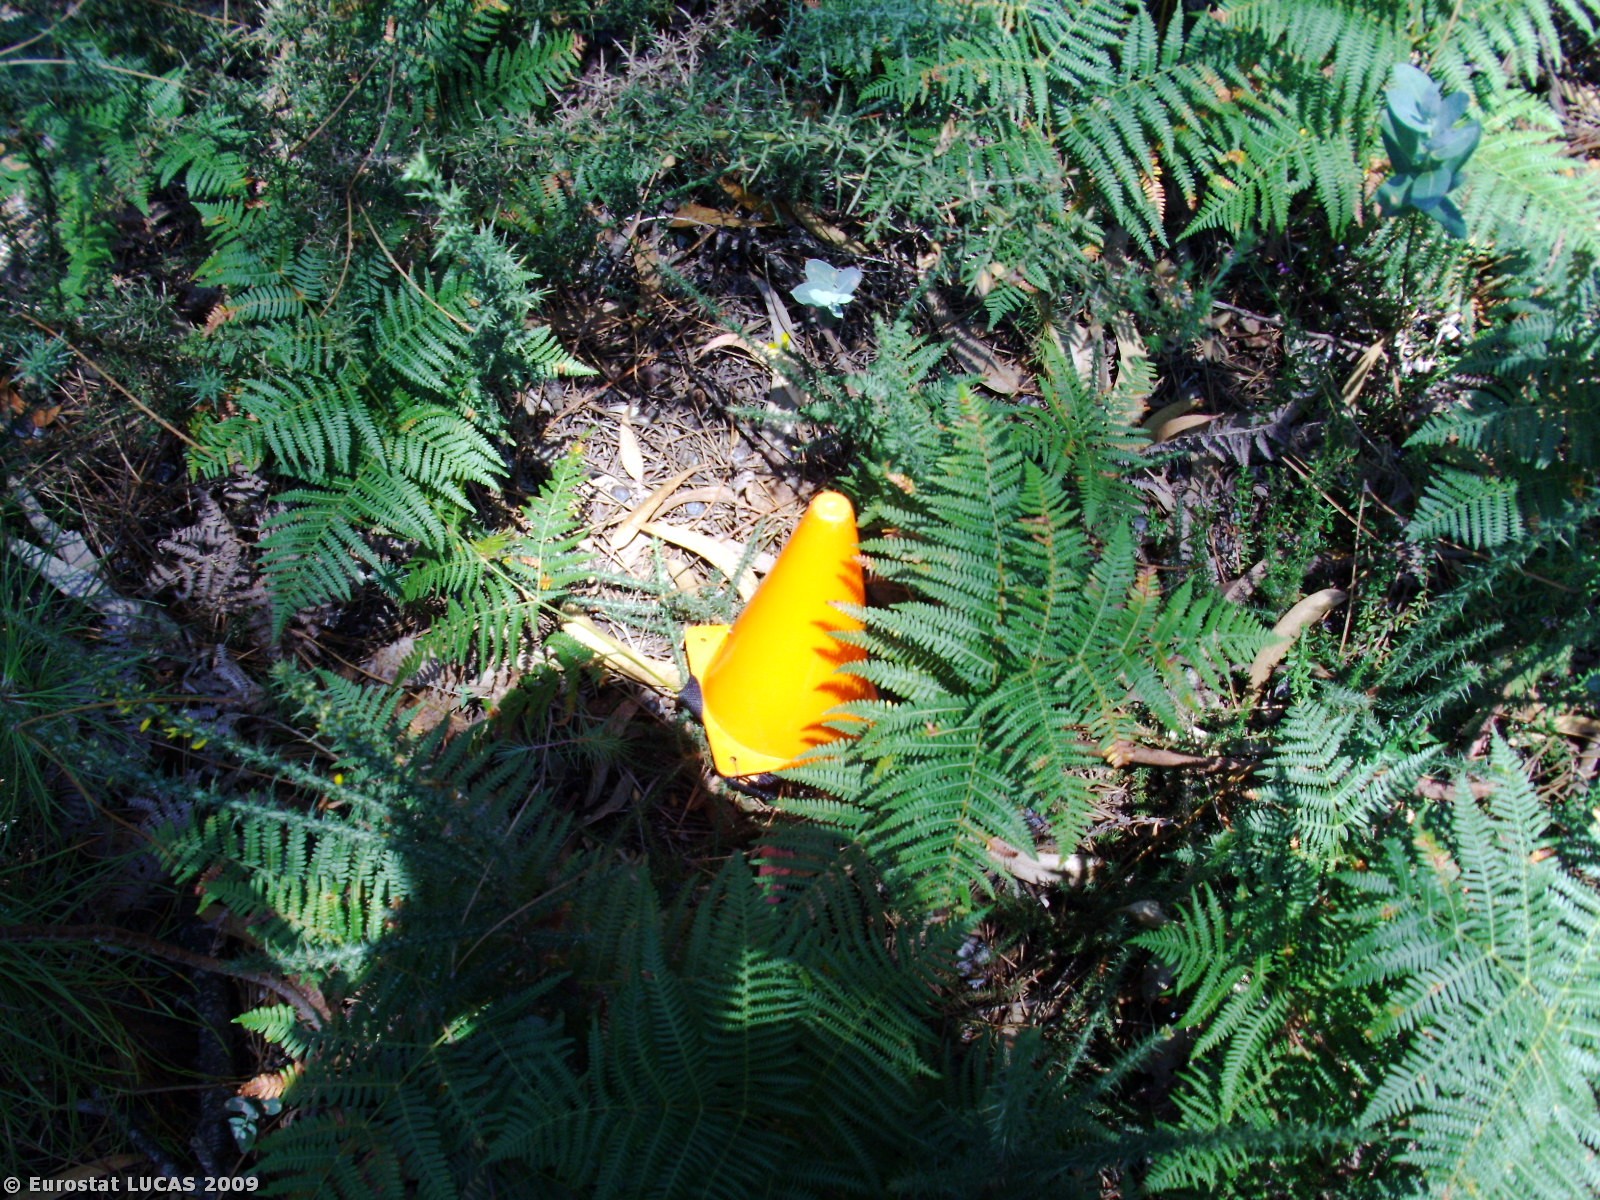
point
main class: Woodland
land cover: Mixed woodland
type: hemiboreal forest and nemoral coniferous forest and mixed broadleaved-coniferous forest
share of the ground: > 75 %
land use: Forestry
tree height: > 5 m
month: July
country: PT
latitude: 41.6183
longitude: -8.7798
